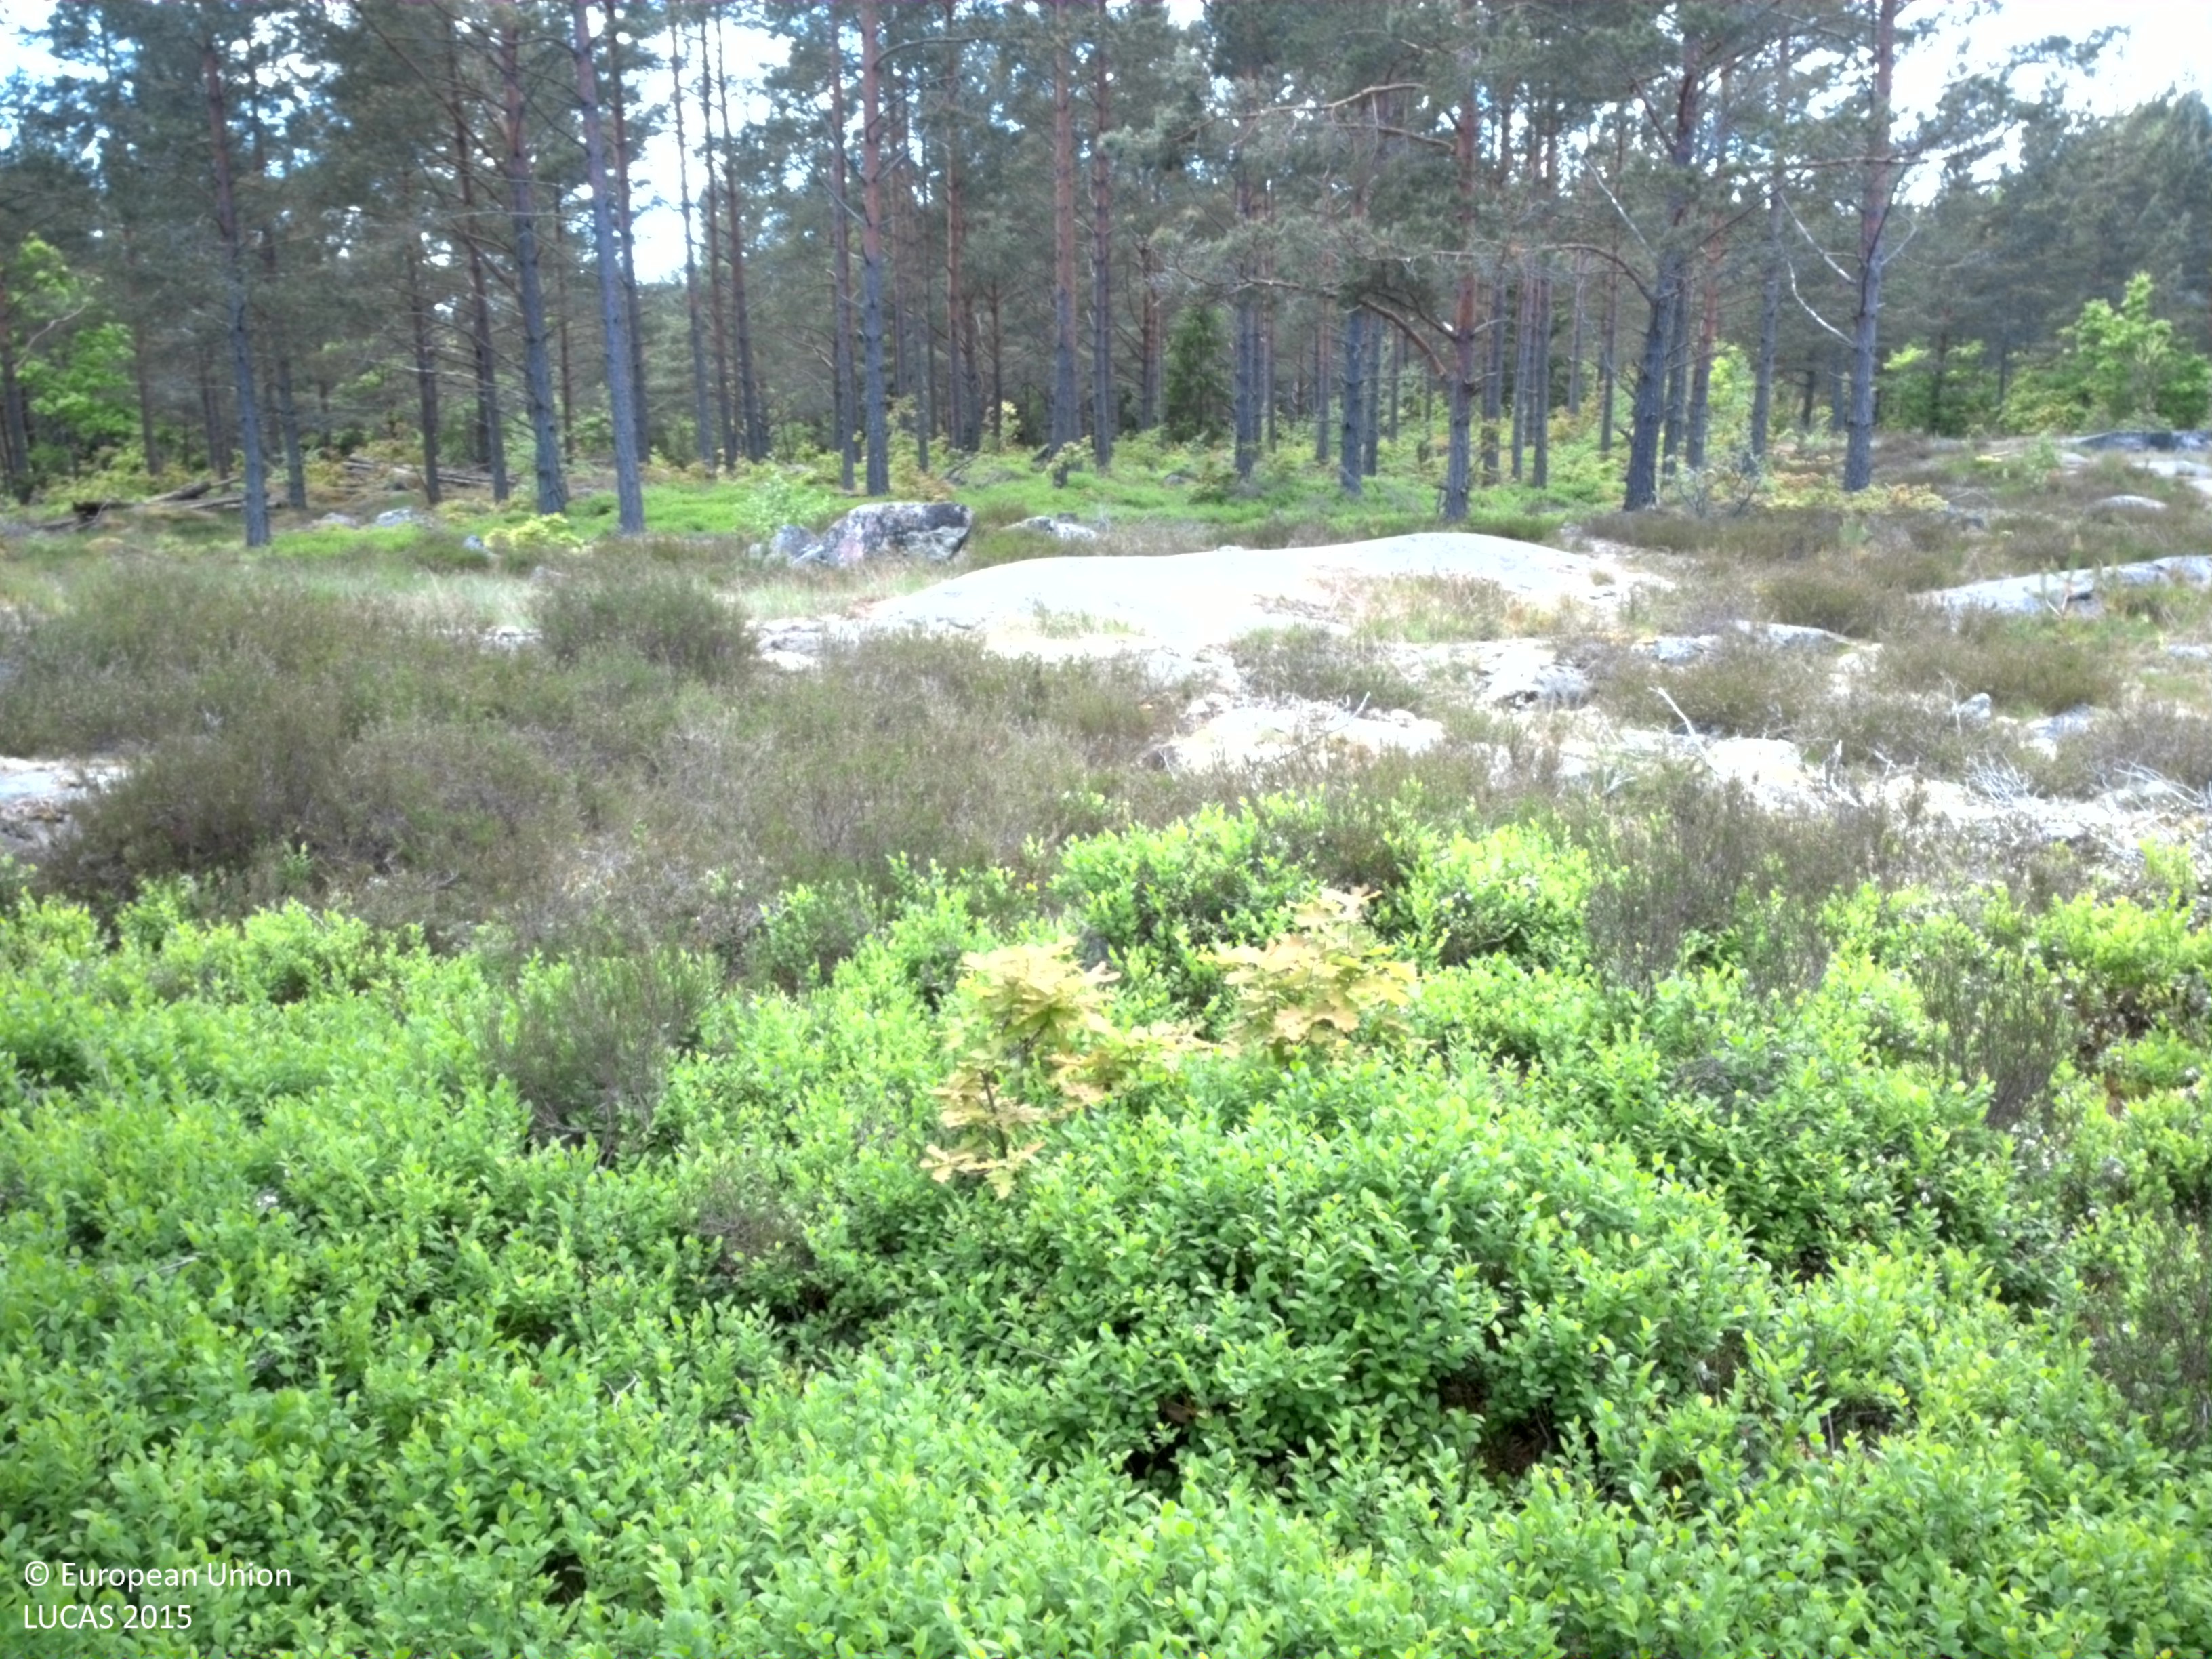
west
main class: Woodland
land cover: Pine dominated coniferous woodland
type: boreal forest
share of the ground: 50 - 75 %
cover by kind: coniferous forest trees 50 %, shrubs 25 %, lichens and mosses 25 %
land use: Forestry
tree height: > 5 m
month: May
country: SE
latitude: 57.1631
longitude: 16.4321
